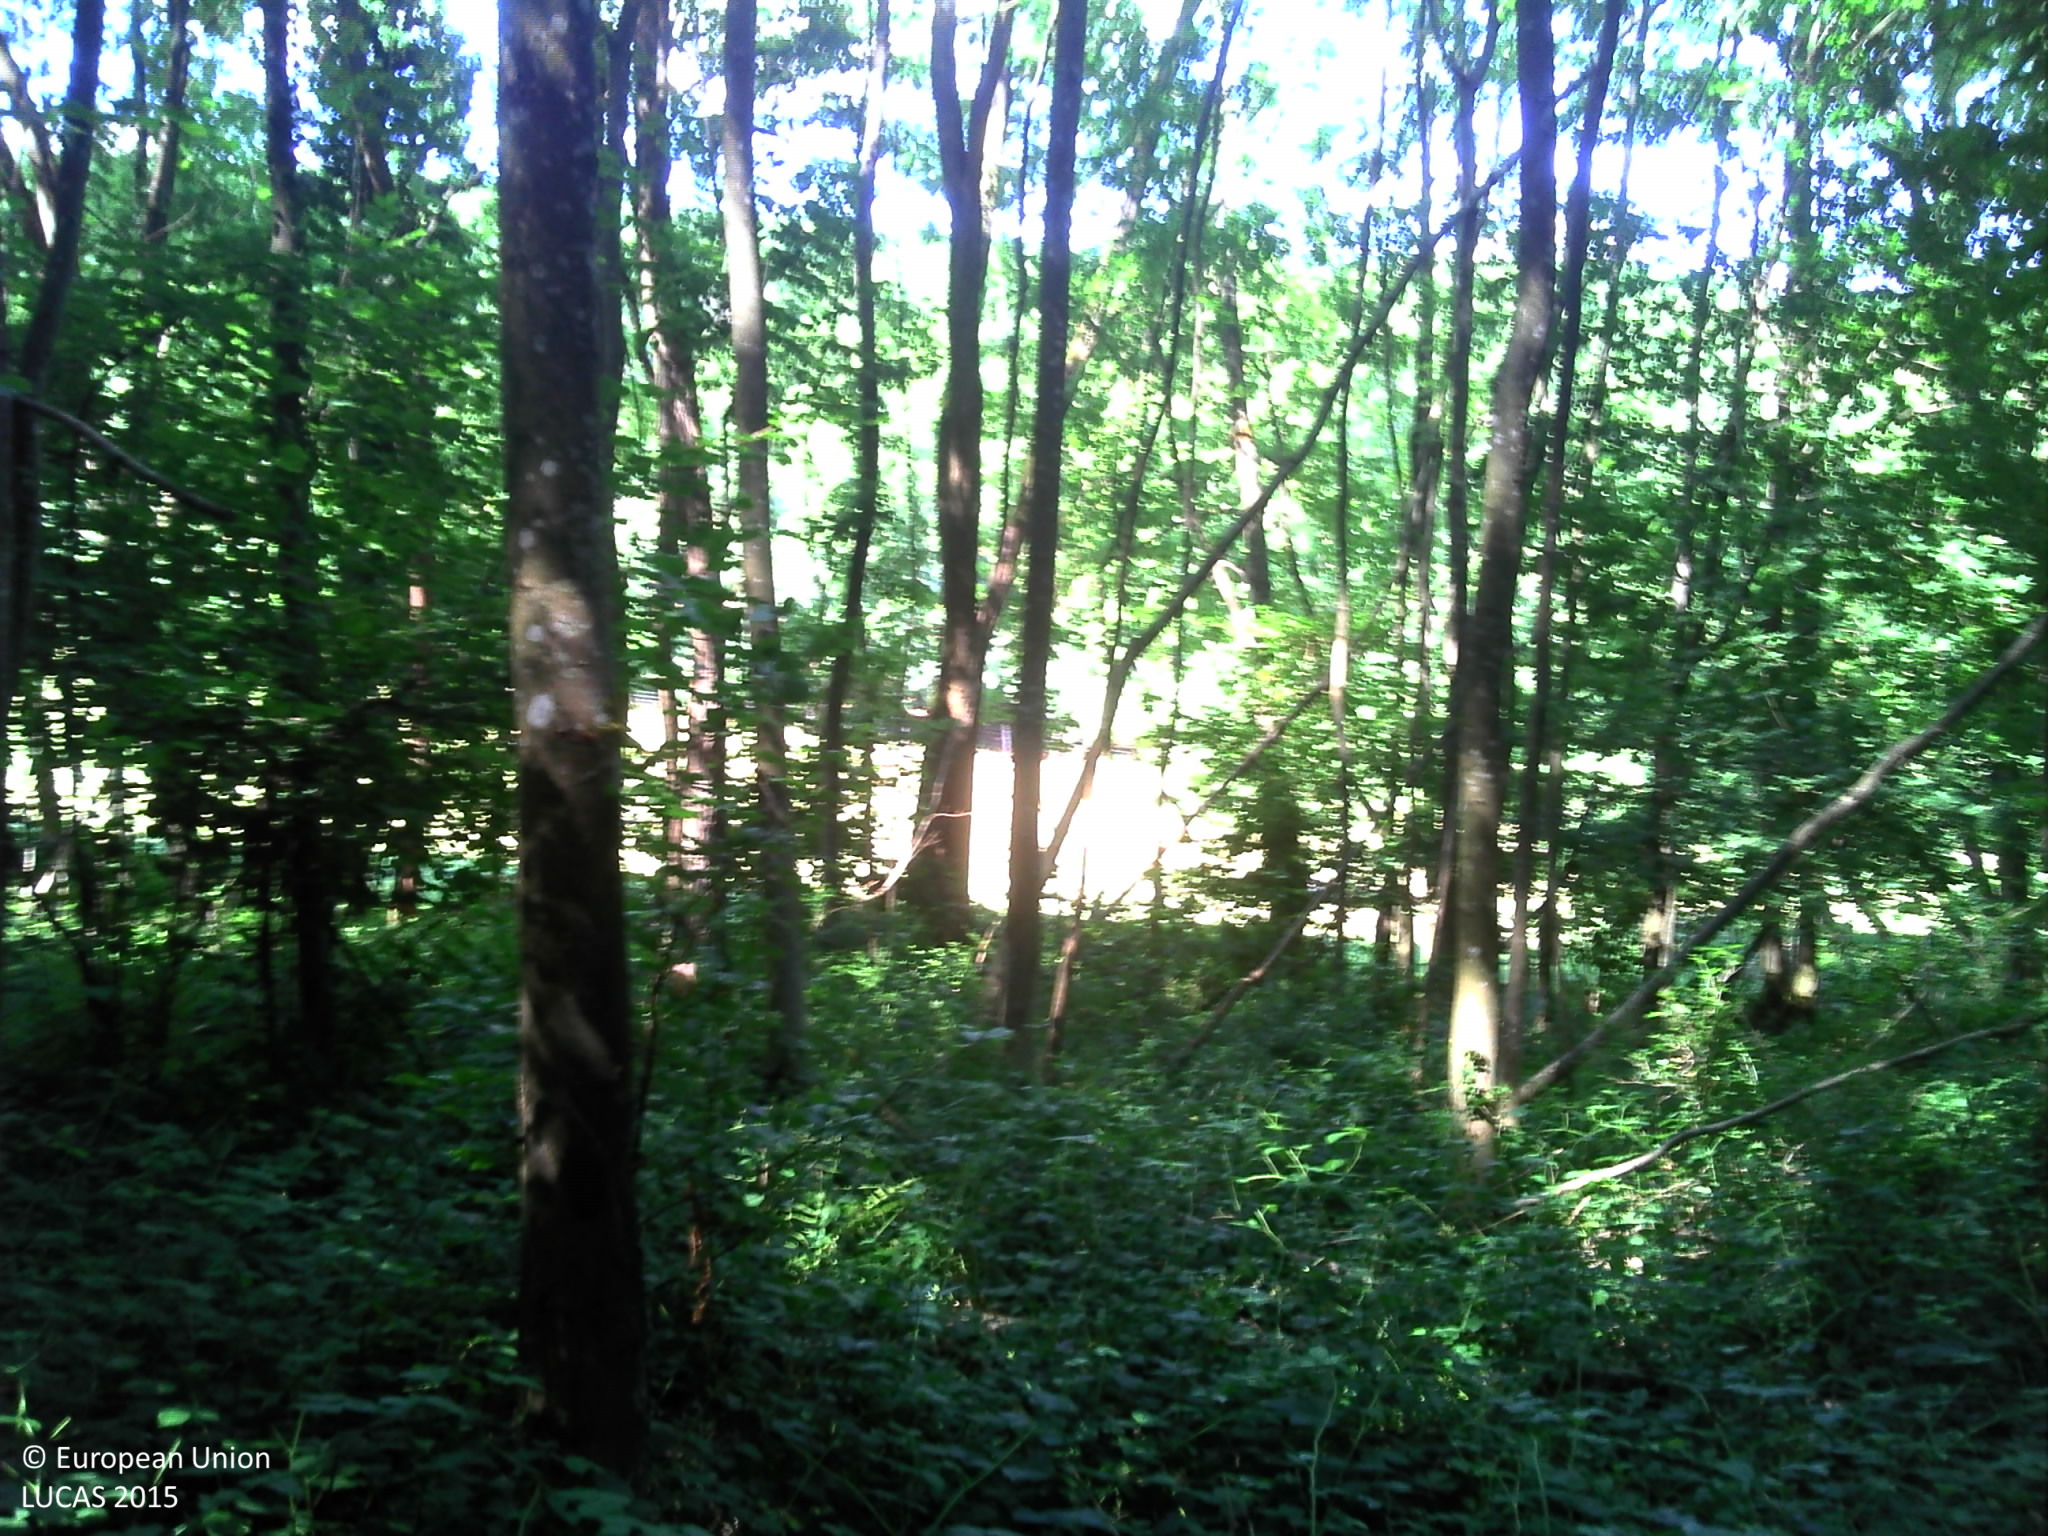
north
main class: Woodland
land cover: Broadleaved woodland
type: mesophytic deciduous forest
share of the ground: > 75 %
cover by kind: broadleaved forest trees 85 %, herbaceous plants 15 %
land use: Forestry
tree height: > 5 m
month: July
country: FR
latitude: 48.6072
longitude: 7.4104
